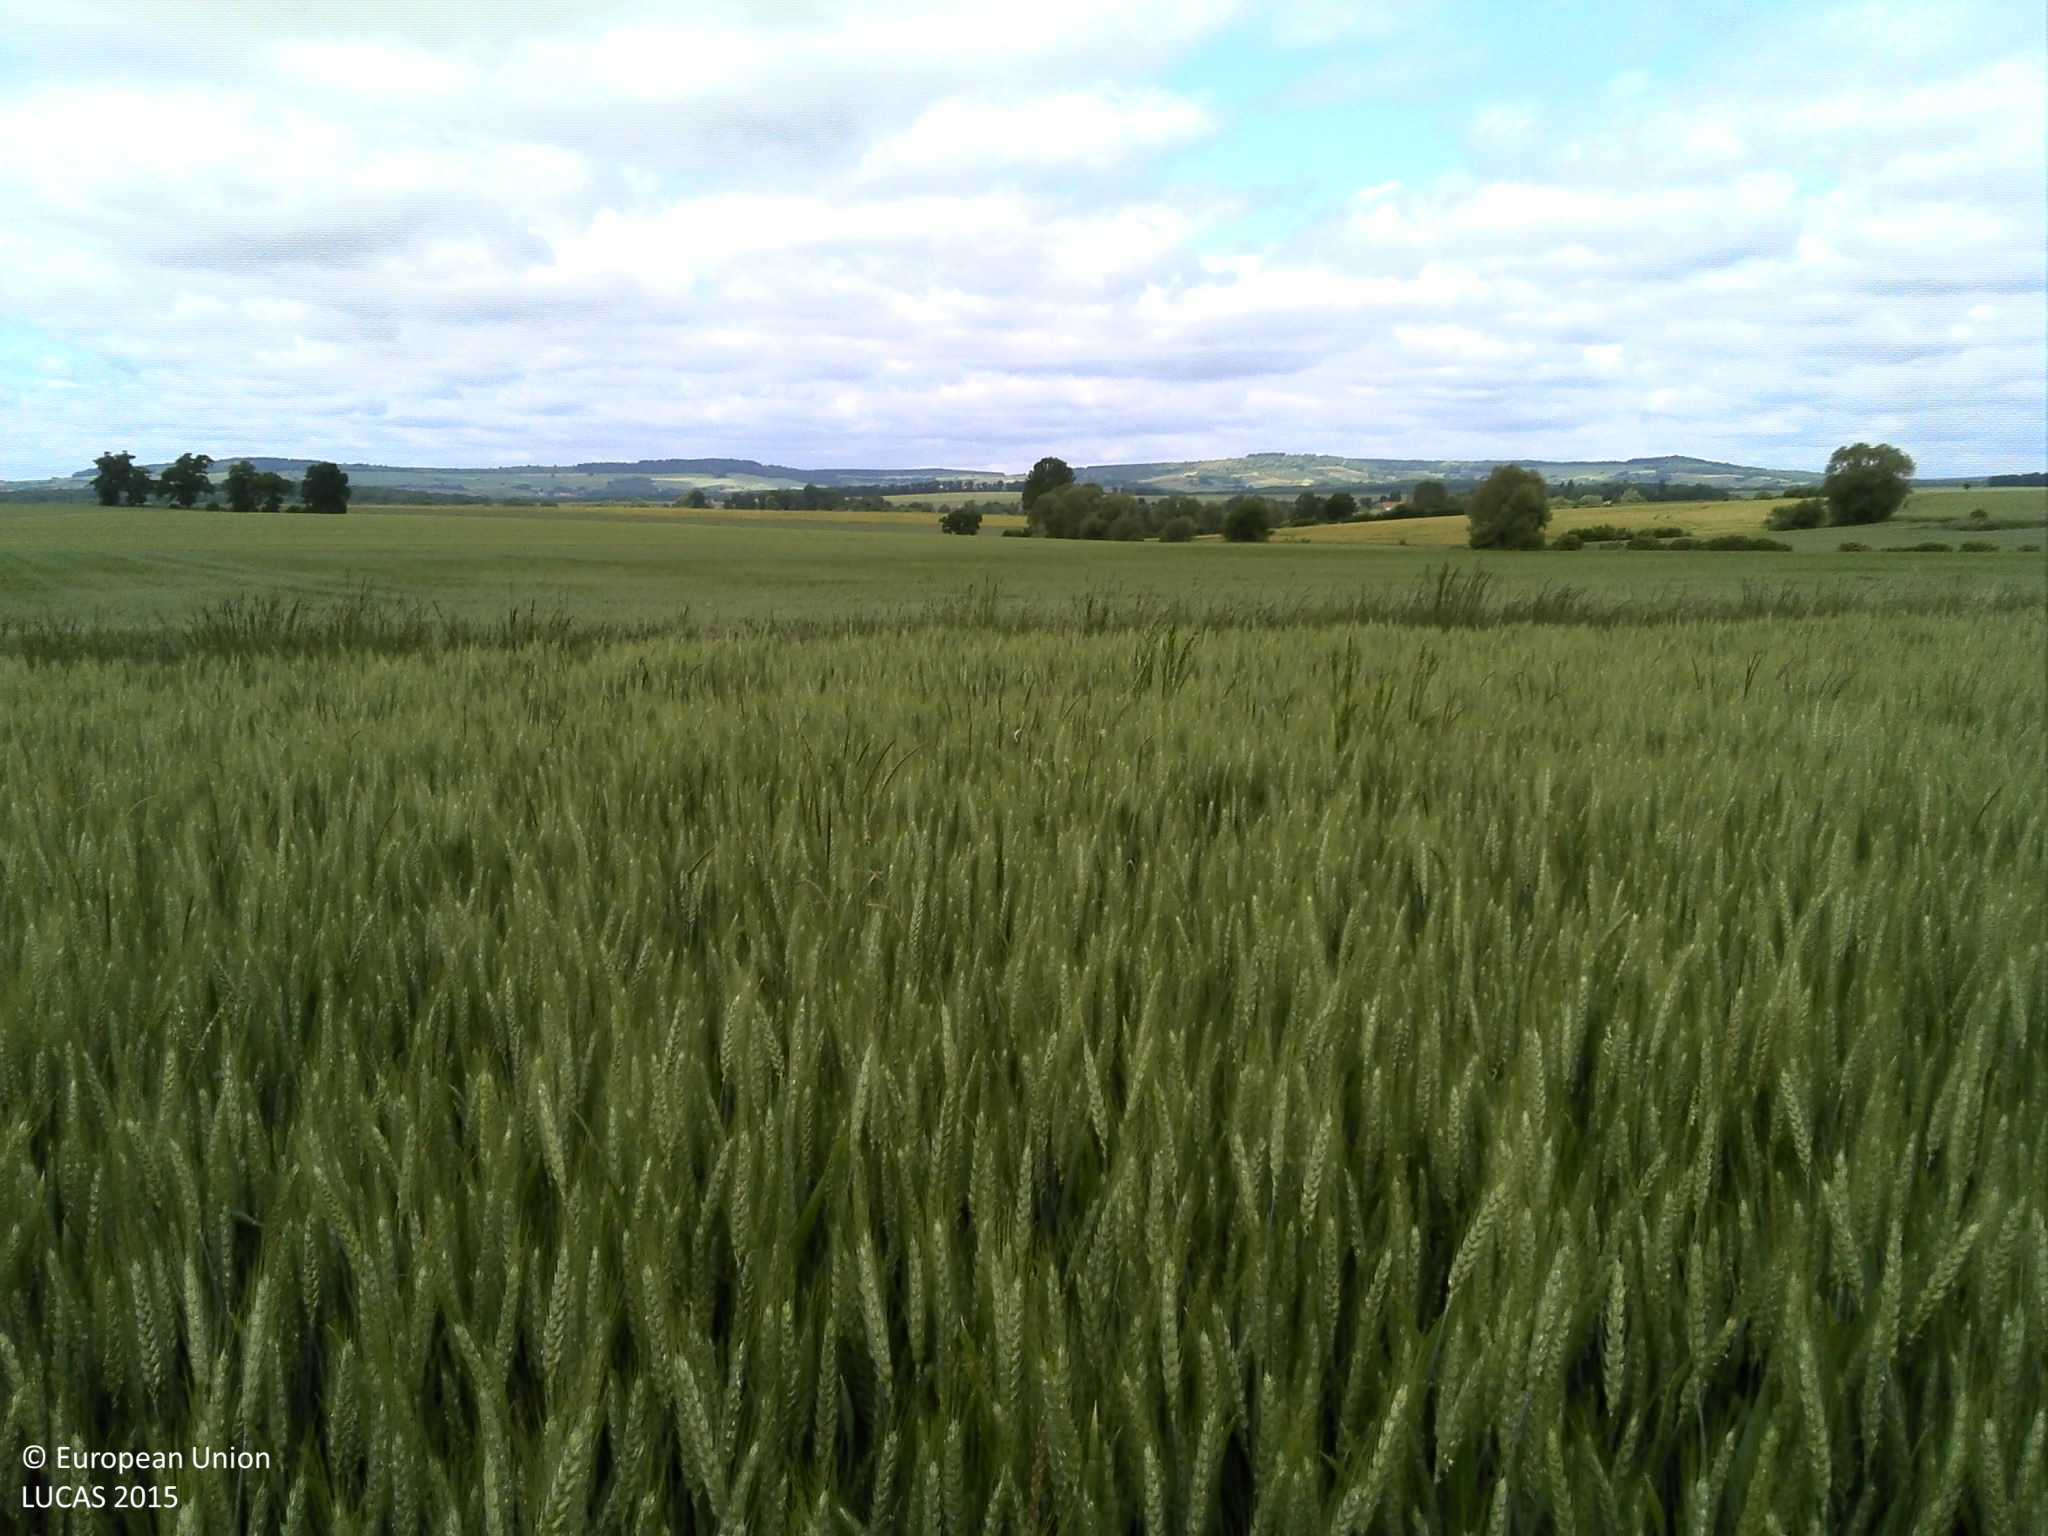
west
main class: Cropland
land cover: Common wheat
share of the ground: > 75 %
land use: Agriculture (excluding fallow land and kitchen gardens)
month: June
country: FR
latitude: 48.9862
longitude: 6.1873
